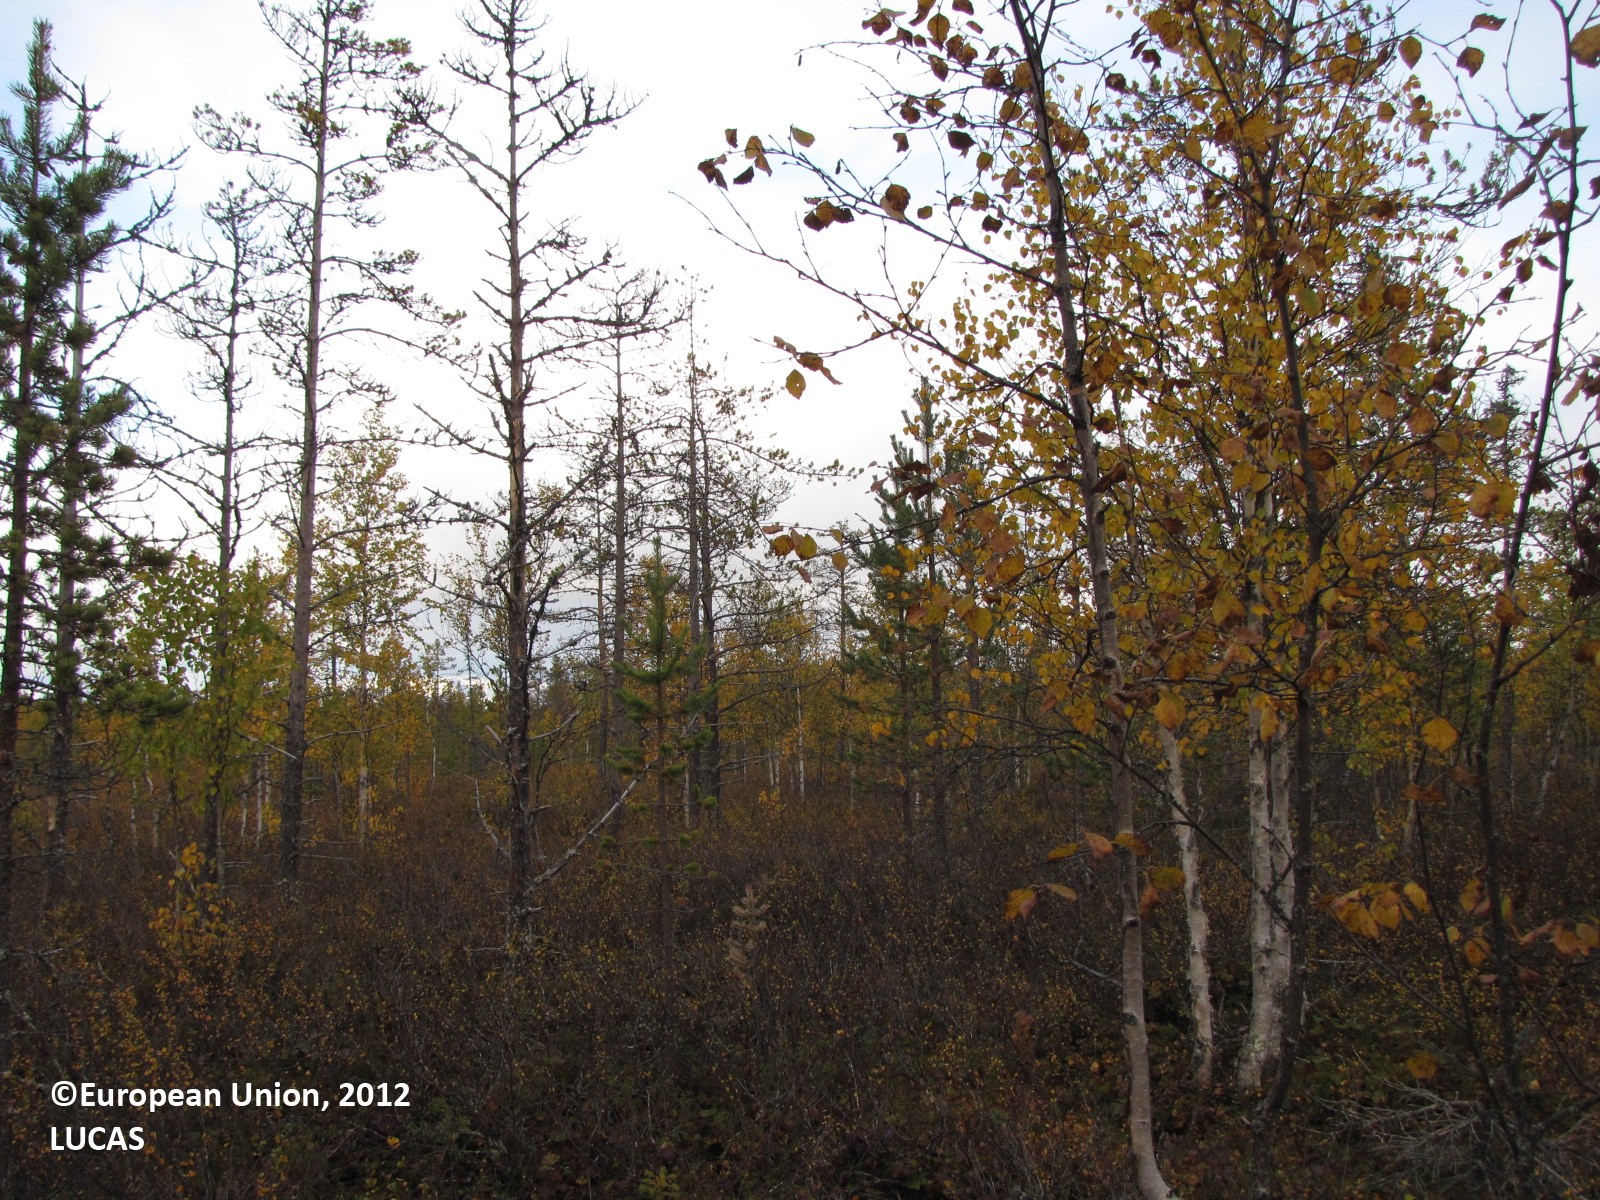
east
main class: Woodland
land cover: Pine dominated mixed woodland
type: boreal forest
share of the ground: 25 - 50 %
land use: Forestry
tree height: > 5 m
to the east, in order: Pine dominated mixed woodland; Ditches and canals; Grassland without tree/shrub cover; Ditches and canals; Pine dominated mixed woodland; Ditches and canals; Grassland without tree/shrub cover; Ditches and canals; Grassland without tree/shrub cover; Abandoned hedges; Ditches and canals; Grassland without tree/shrub cover; Shruby margins; Ditches and canals; Grassland without tree/shrub cover; Shruby margins; Ditches and canals; Grassland without tree/shrub cover; Shruby margins; Ditches and canals; Grassland without tree/shrub cover; Ditches and canals; Grassland without tree/shrub cover
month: September
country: FI
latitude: 67.3234
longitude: 25.4141
